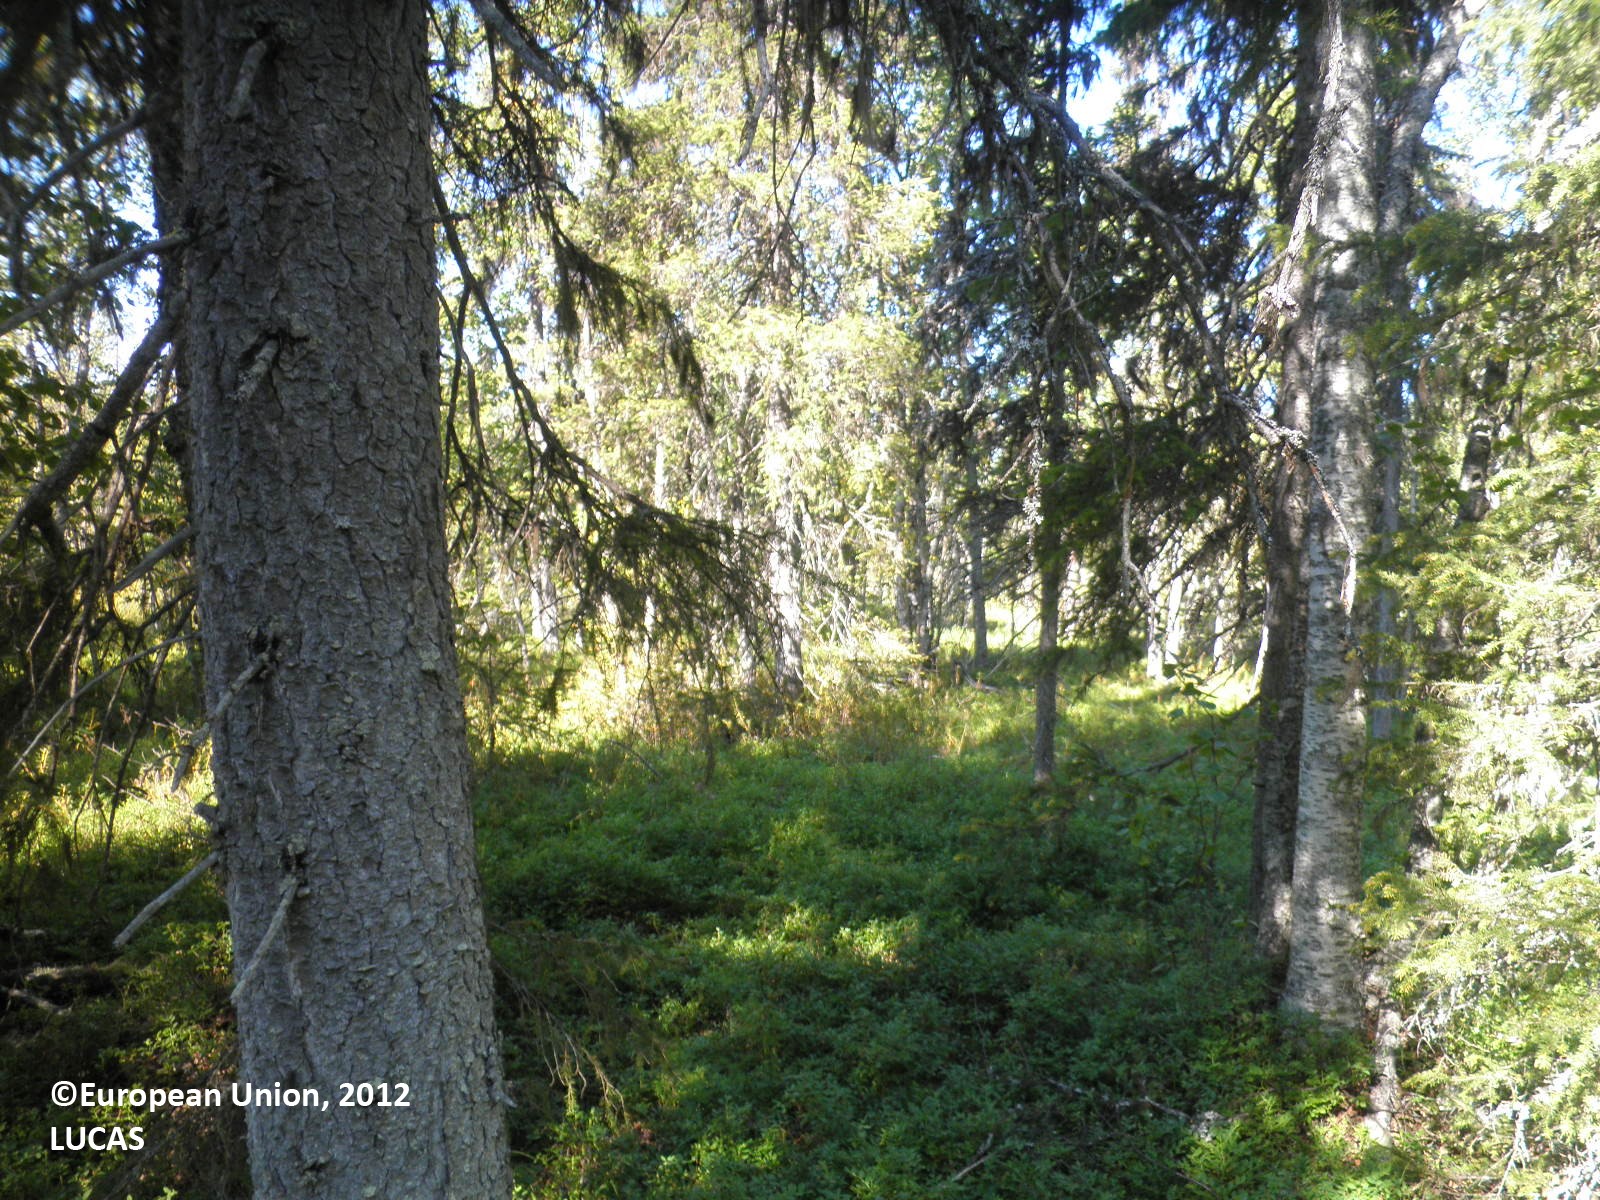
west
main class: Woodland
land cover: Spruce dominated mixed woodland
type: boreal forest
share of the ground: 50 - 75 %
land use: Forestry
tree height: > 5 m
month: August
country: FI
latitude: 67.4881
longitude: 25.8548
